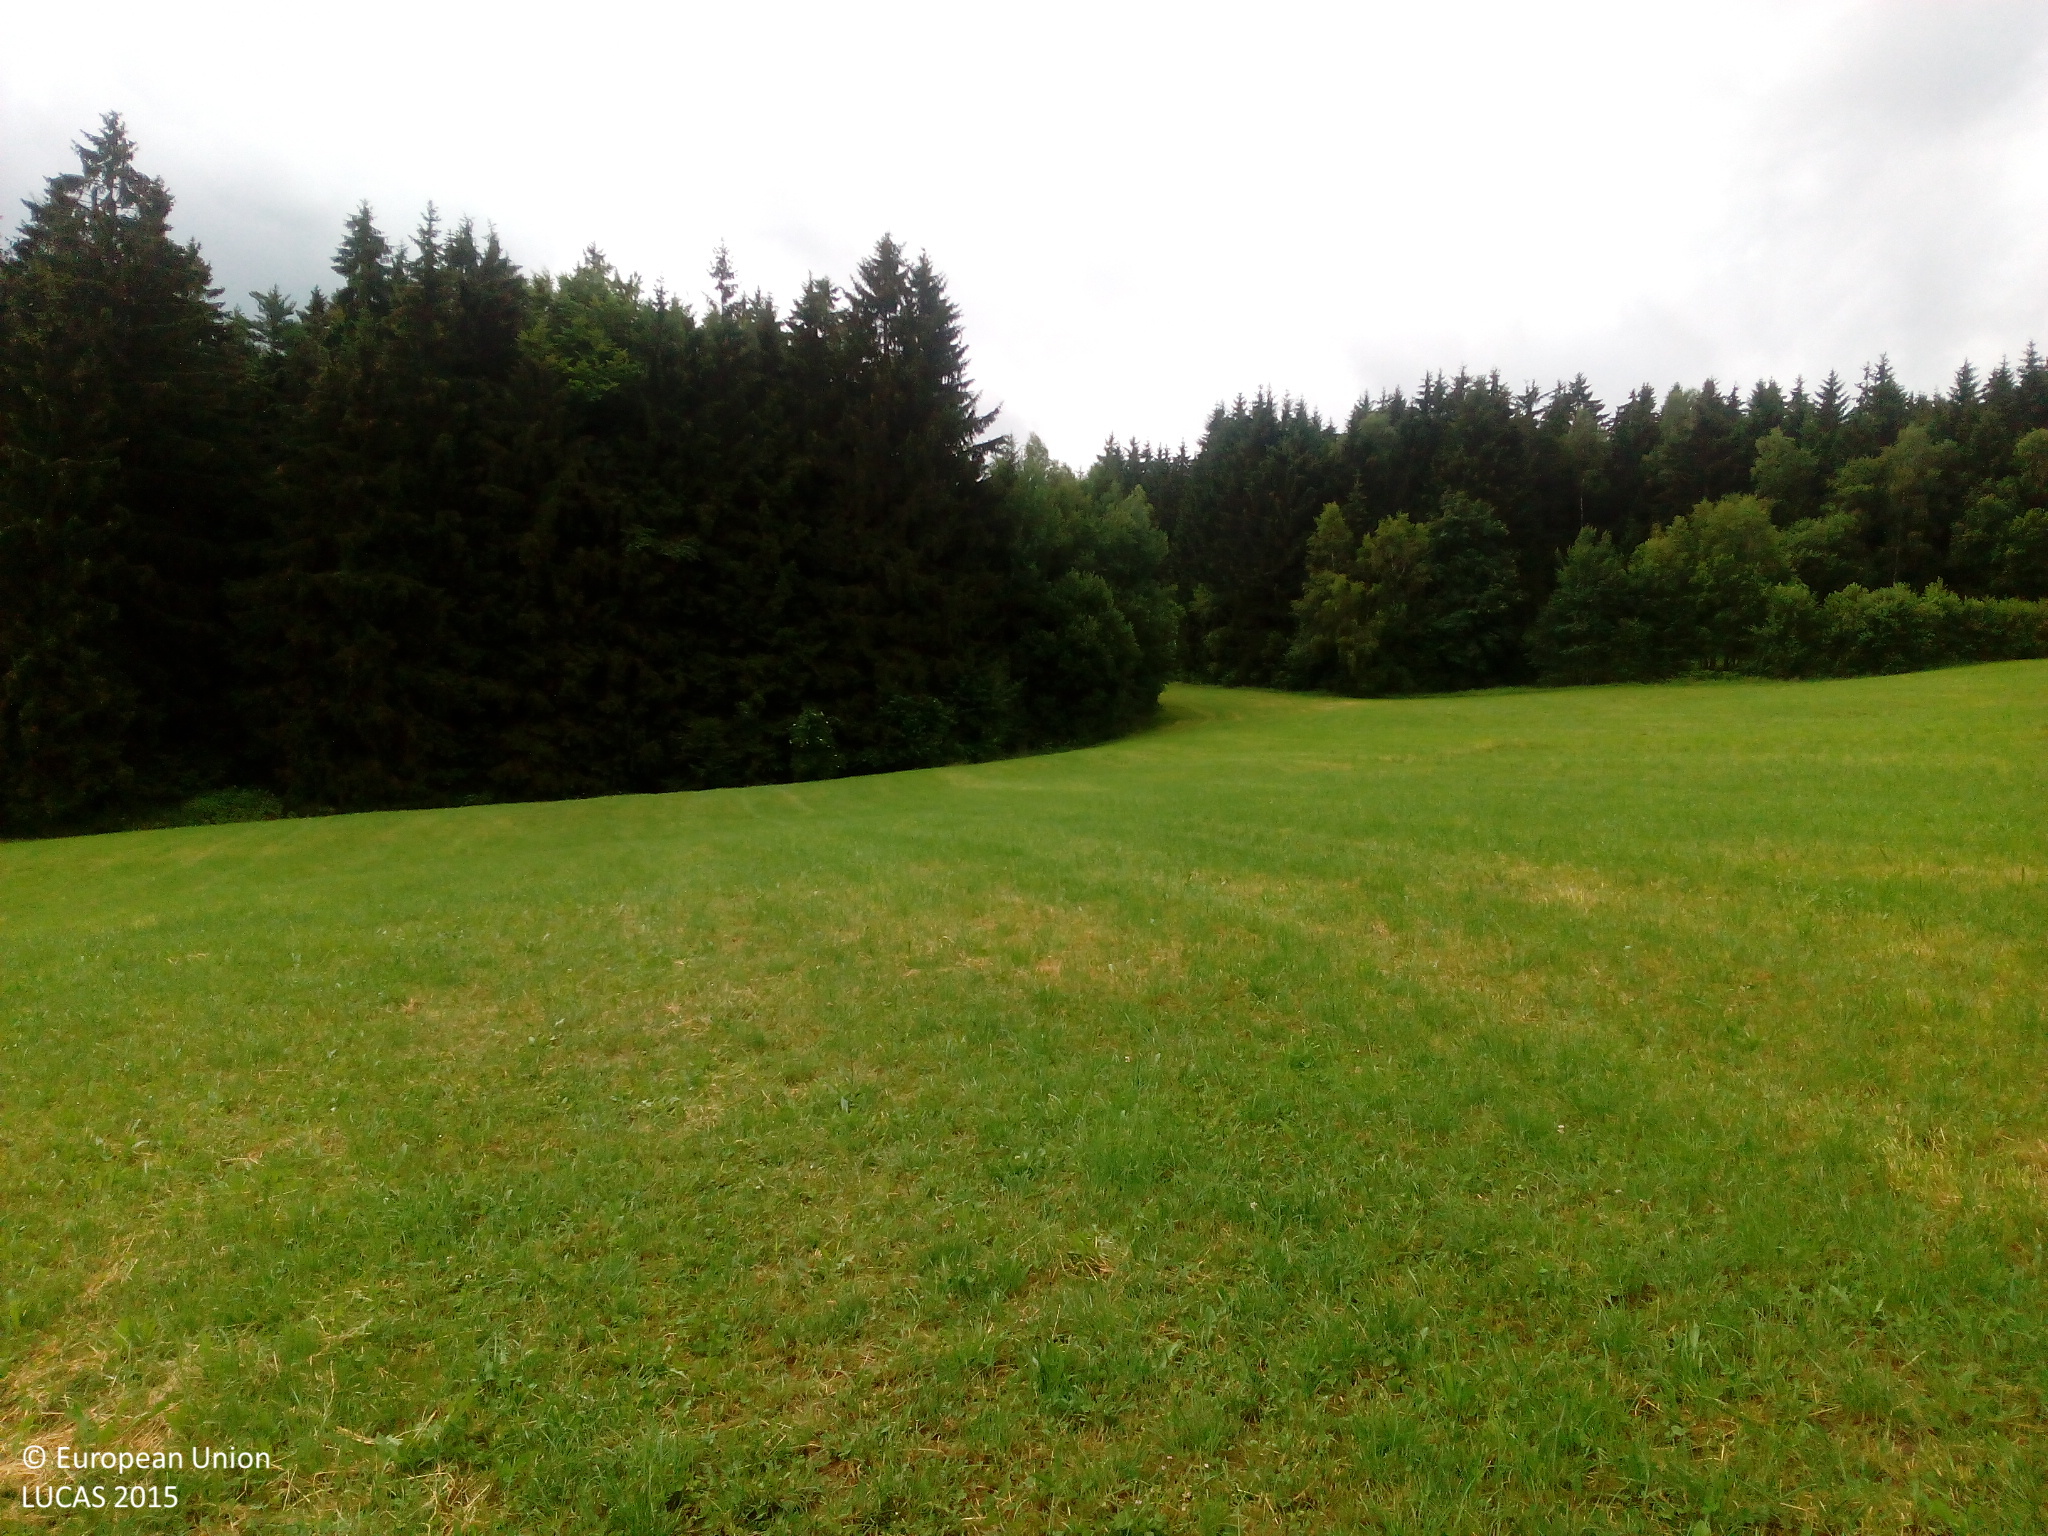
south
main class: Grassland
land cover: Grassland without tree/shrub cover
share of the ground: > 75 %
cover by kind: herbaceous plants 95 %, unconsolidated bare surface 5 %
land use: Agriculture (excluding fallow land and kitchen gardens)
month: July
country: DE
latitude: 49.6739
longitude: 12.3692
